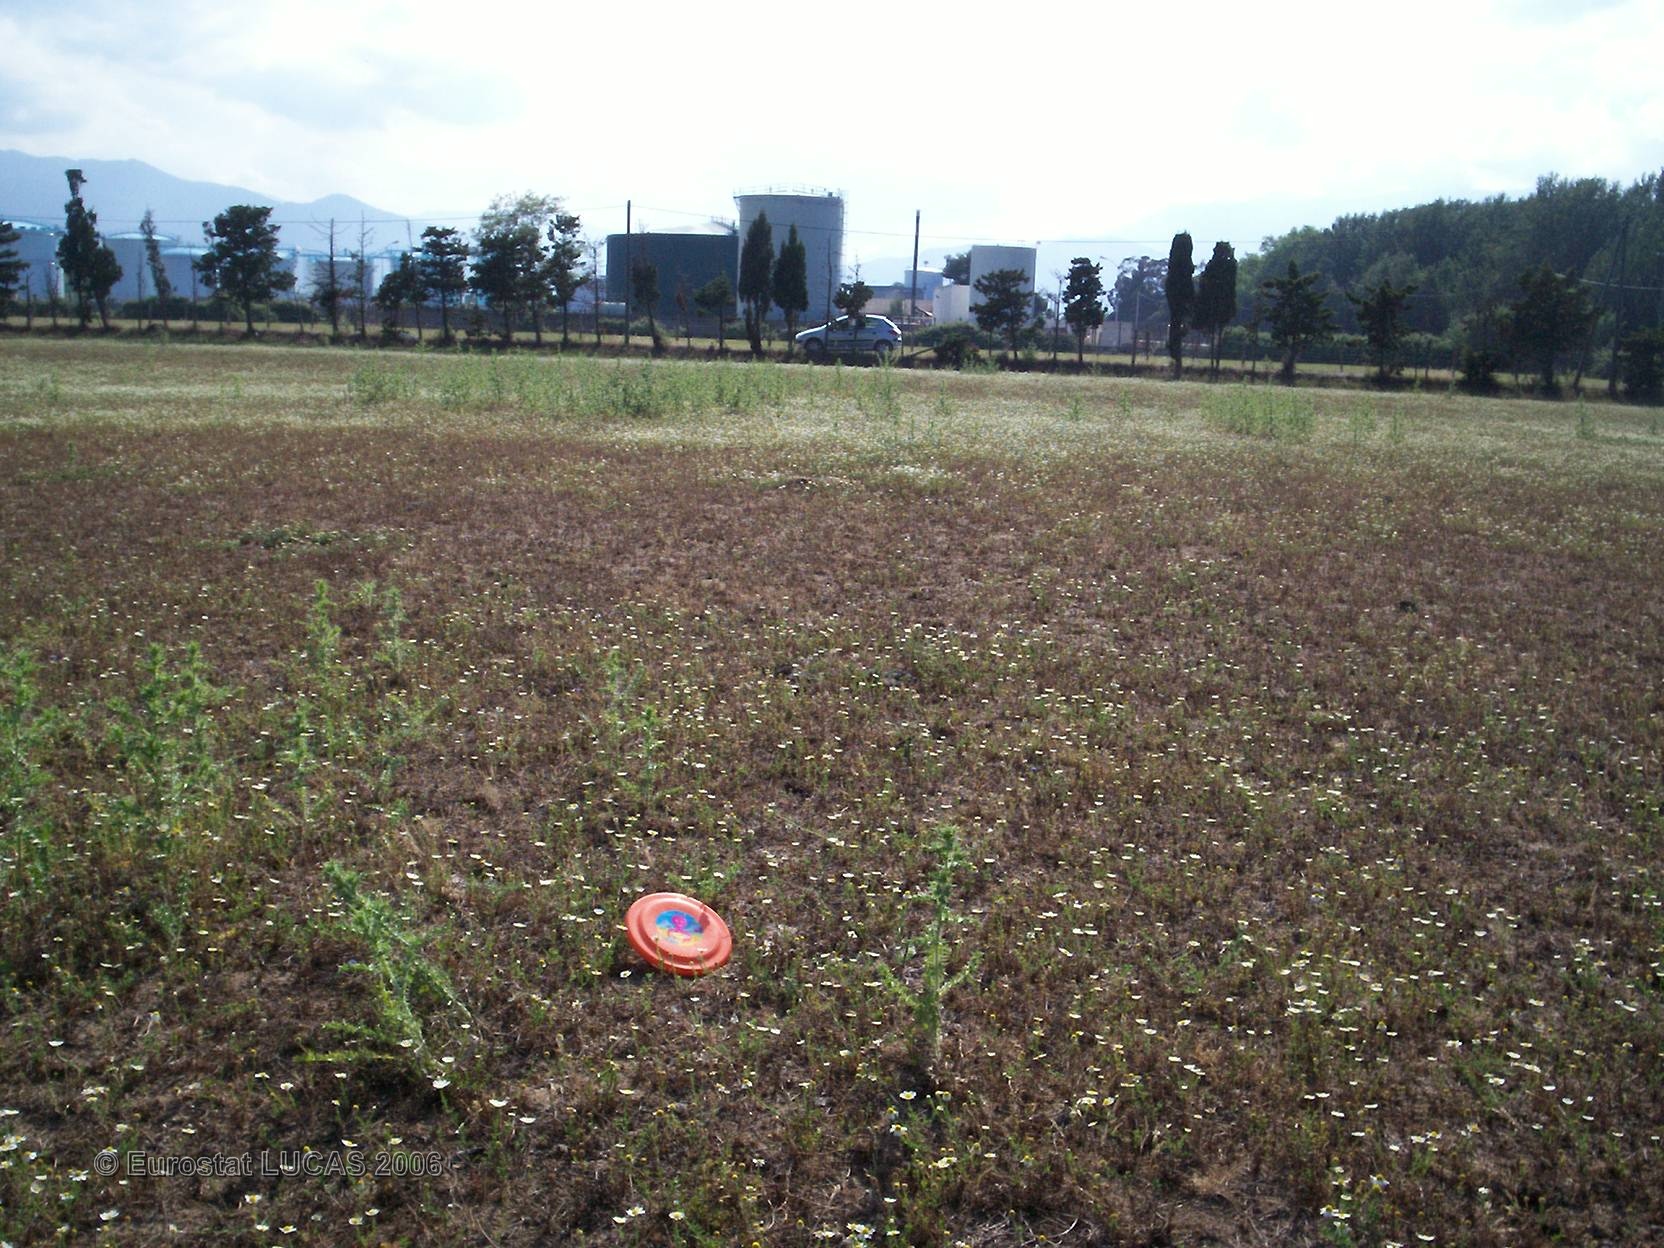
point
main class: Grassland
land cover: Grassland without tree/shrub cover
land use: Agriculture (excluding fallow land and kitchen gardens)
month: June
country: FR
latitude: 42.5445
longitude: 9.5267
